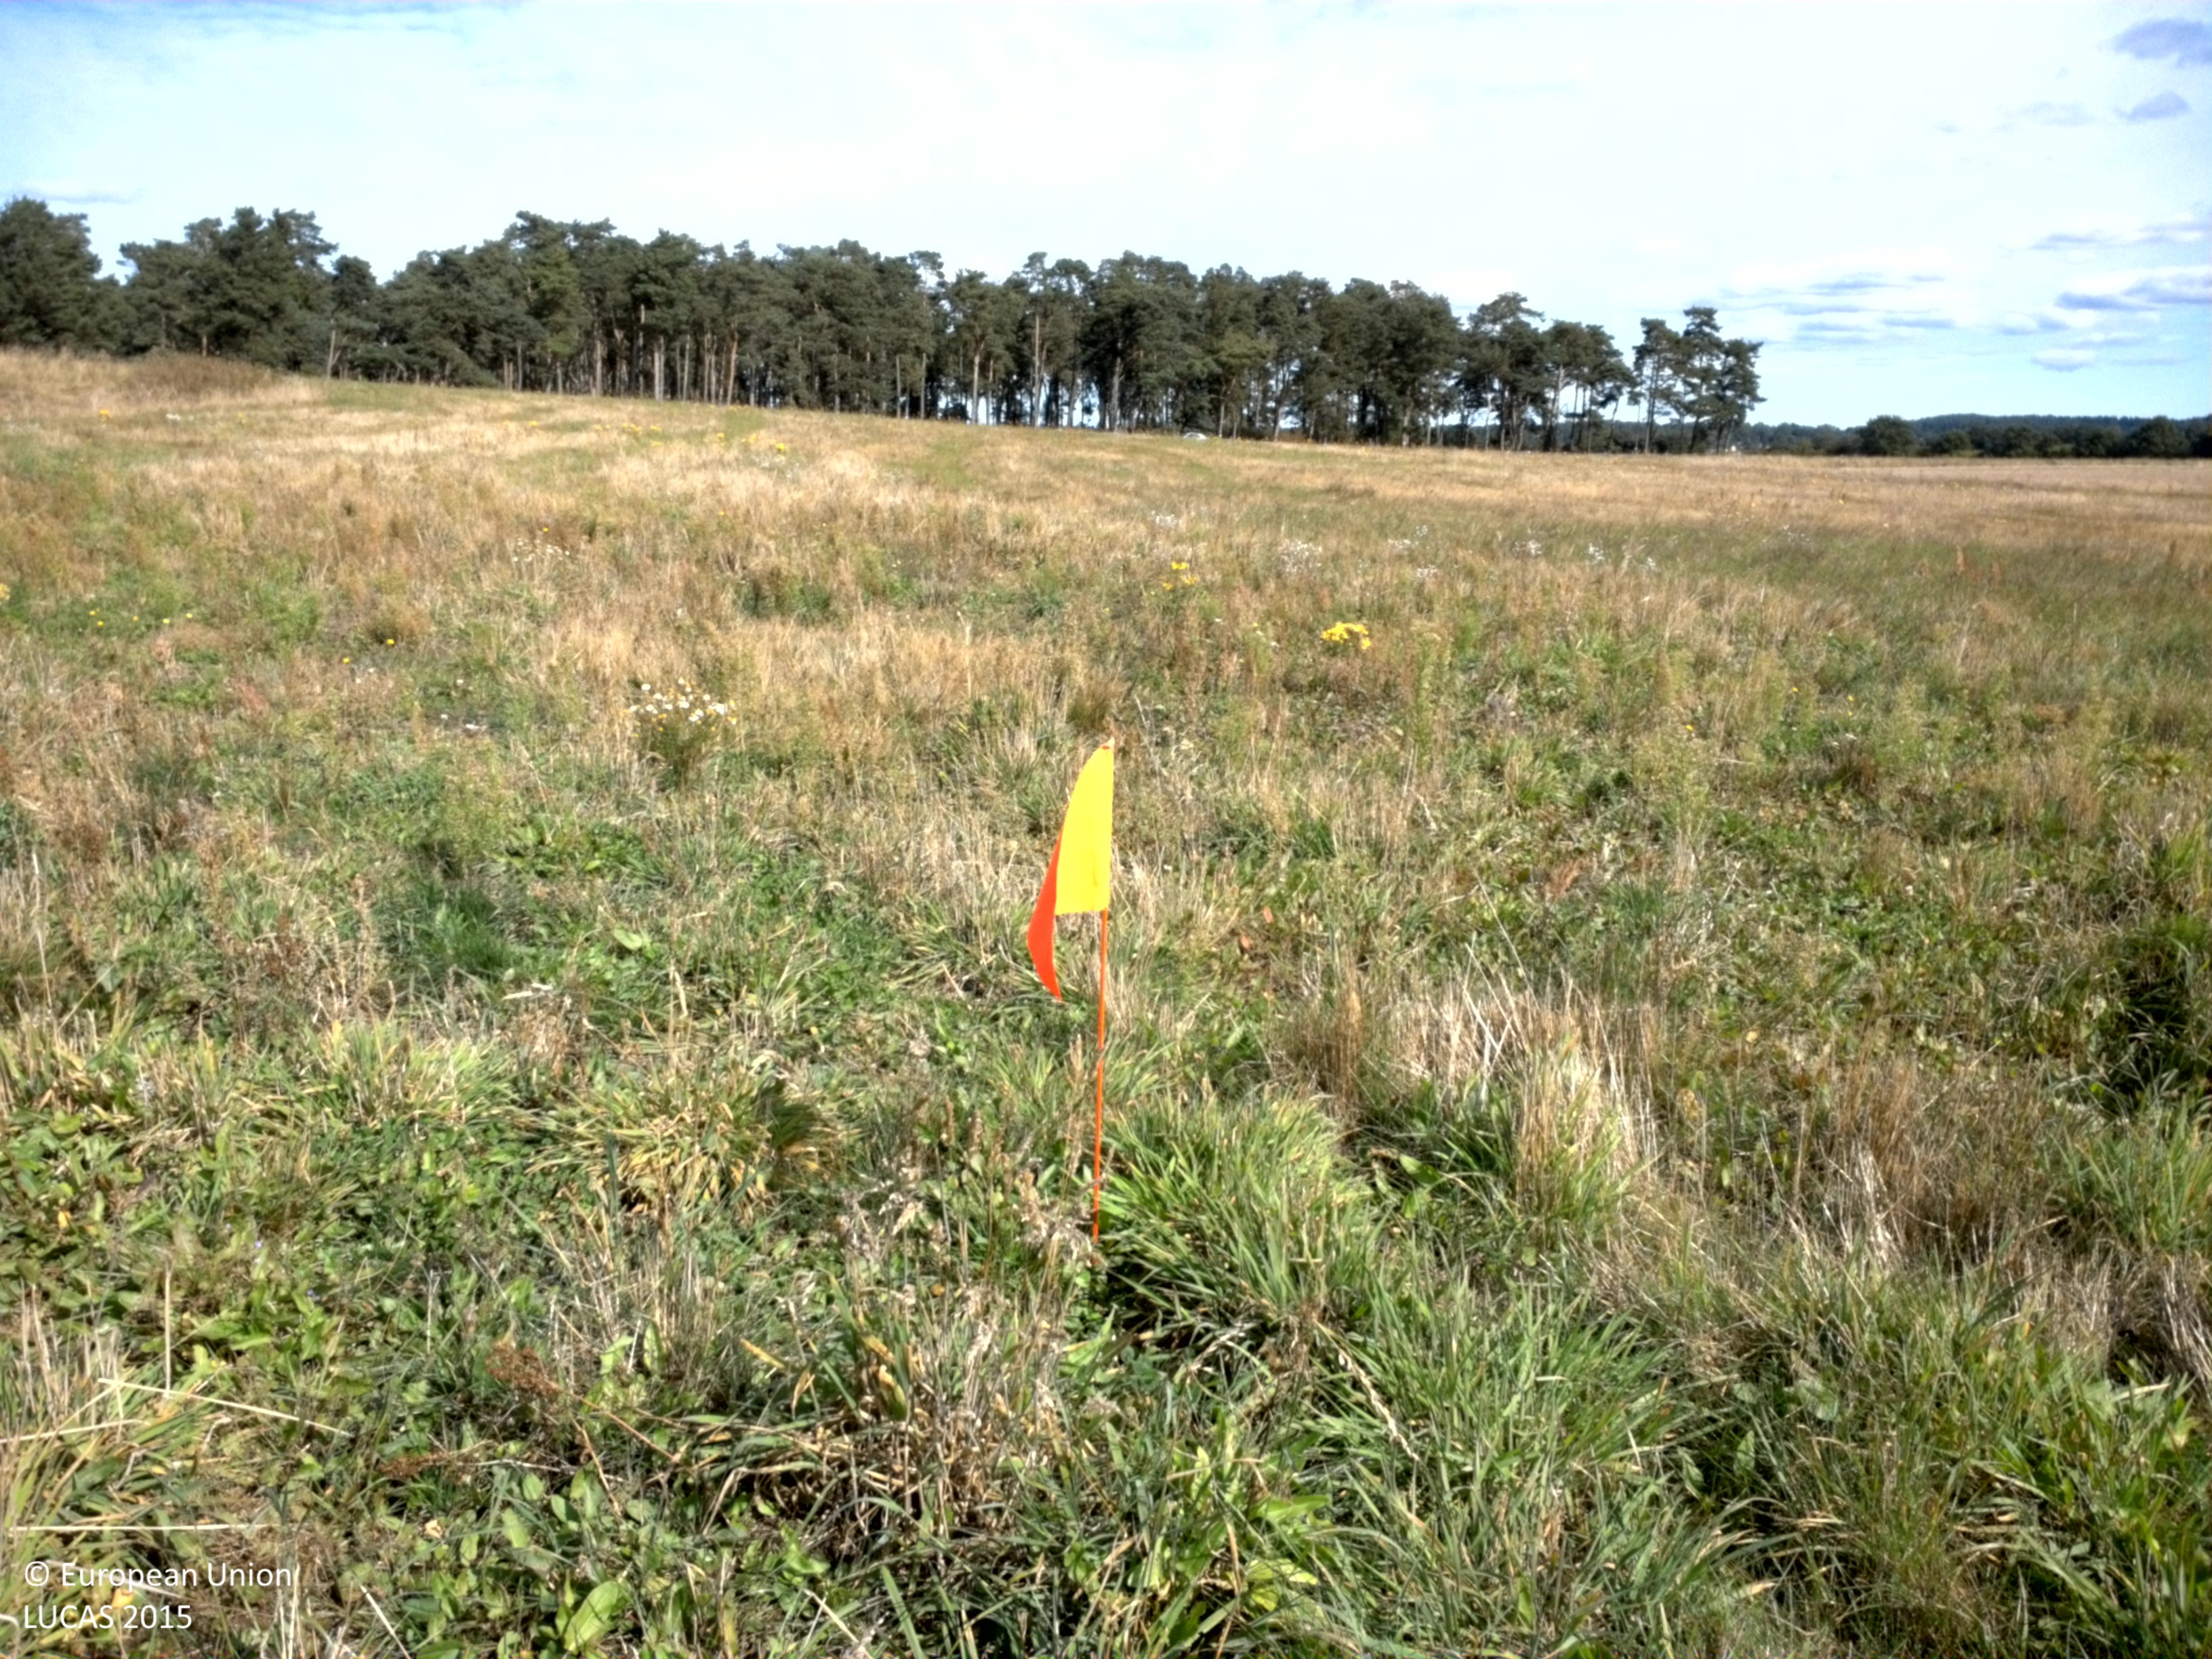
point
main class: Grassland
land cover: Grassland without tree/shrub cover
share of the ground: > 75 %
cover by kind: herbaceous plants 100 %
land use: Agriculture (excluding fallow land and kitchen gardens)
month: September
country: SE
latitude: 55.6136
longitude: 13.6656
